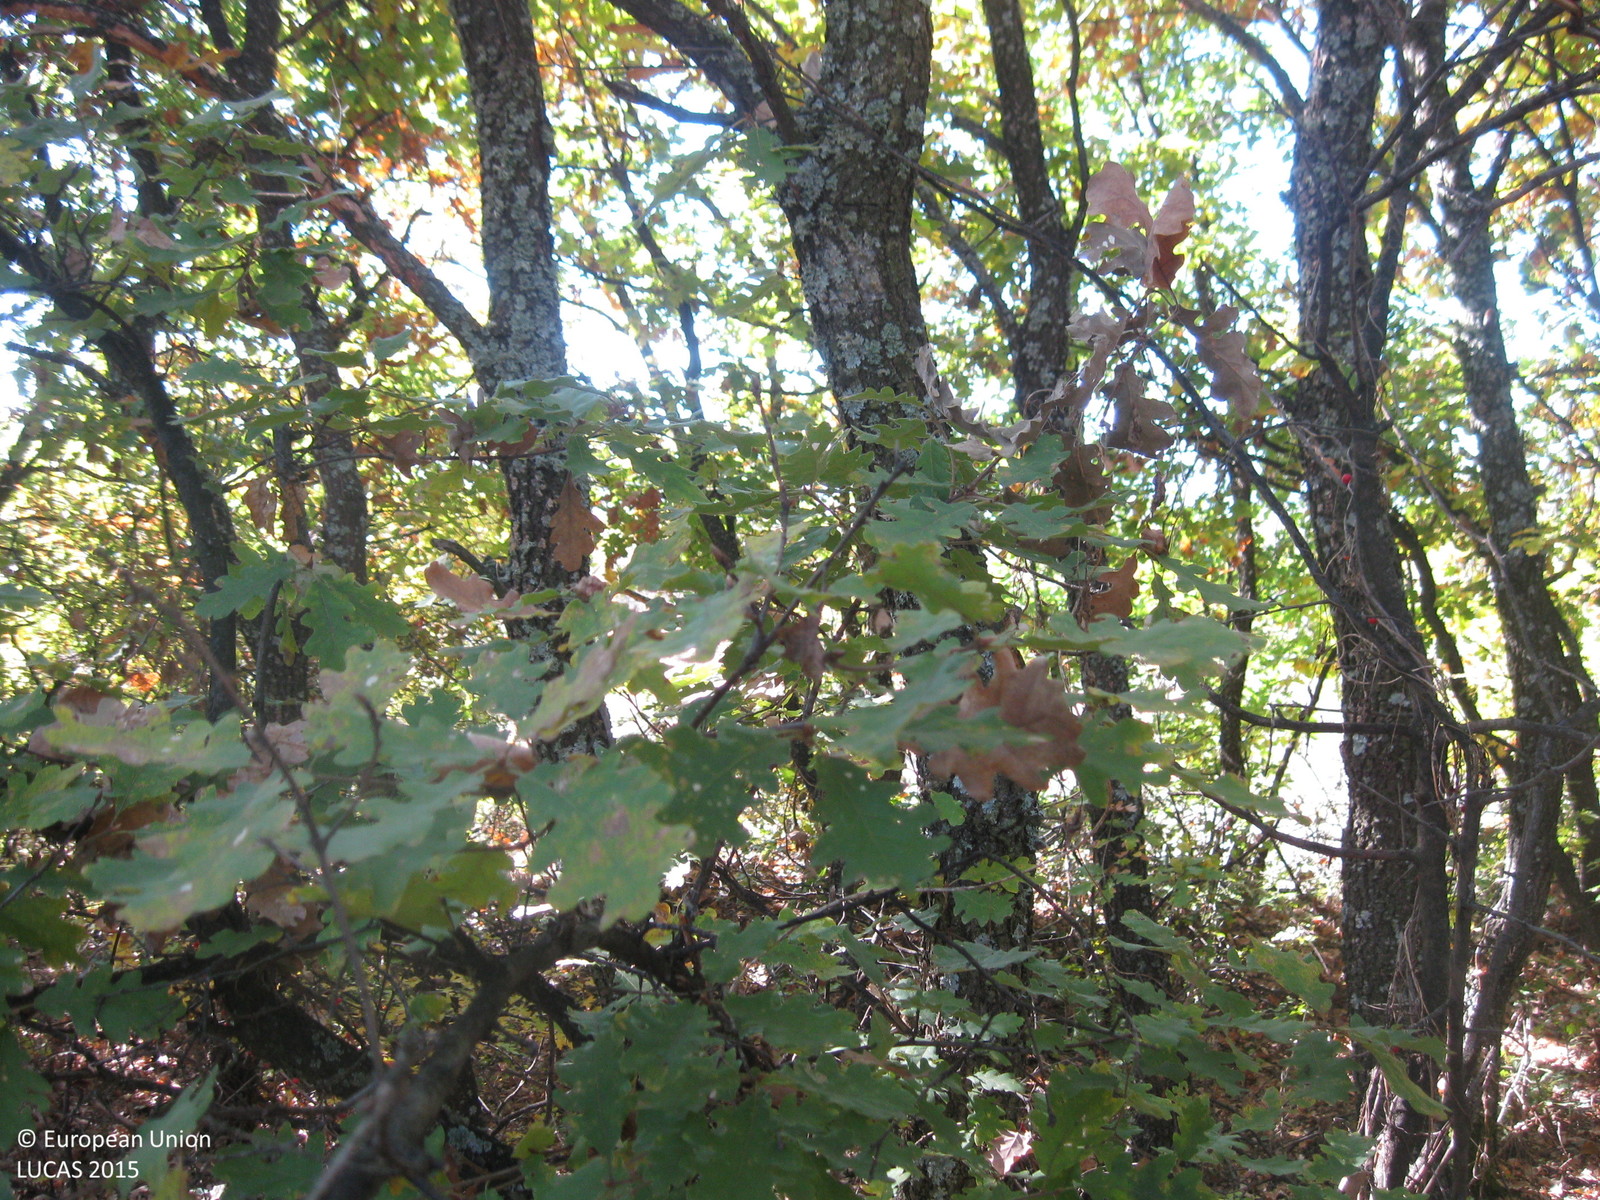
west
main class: Woodland
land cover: Broadleaved woodland
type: thermophilous deciduous forest
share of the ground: > 75 %
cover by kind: broadleaved forest trees 90 %, shrubs 5 %, herbaceous plants 5 %
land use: Forestry
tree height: > 5 m
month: November
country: BG
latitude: 42.3531
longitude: 24.2614
